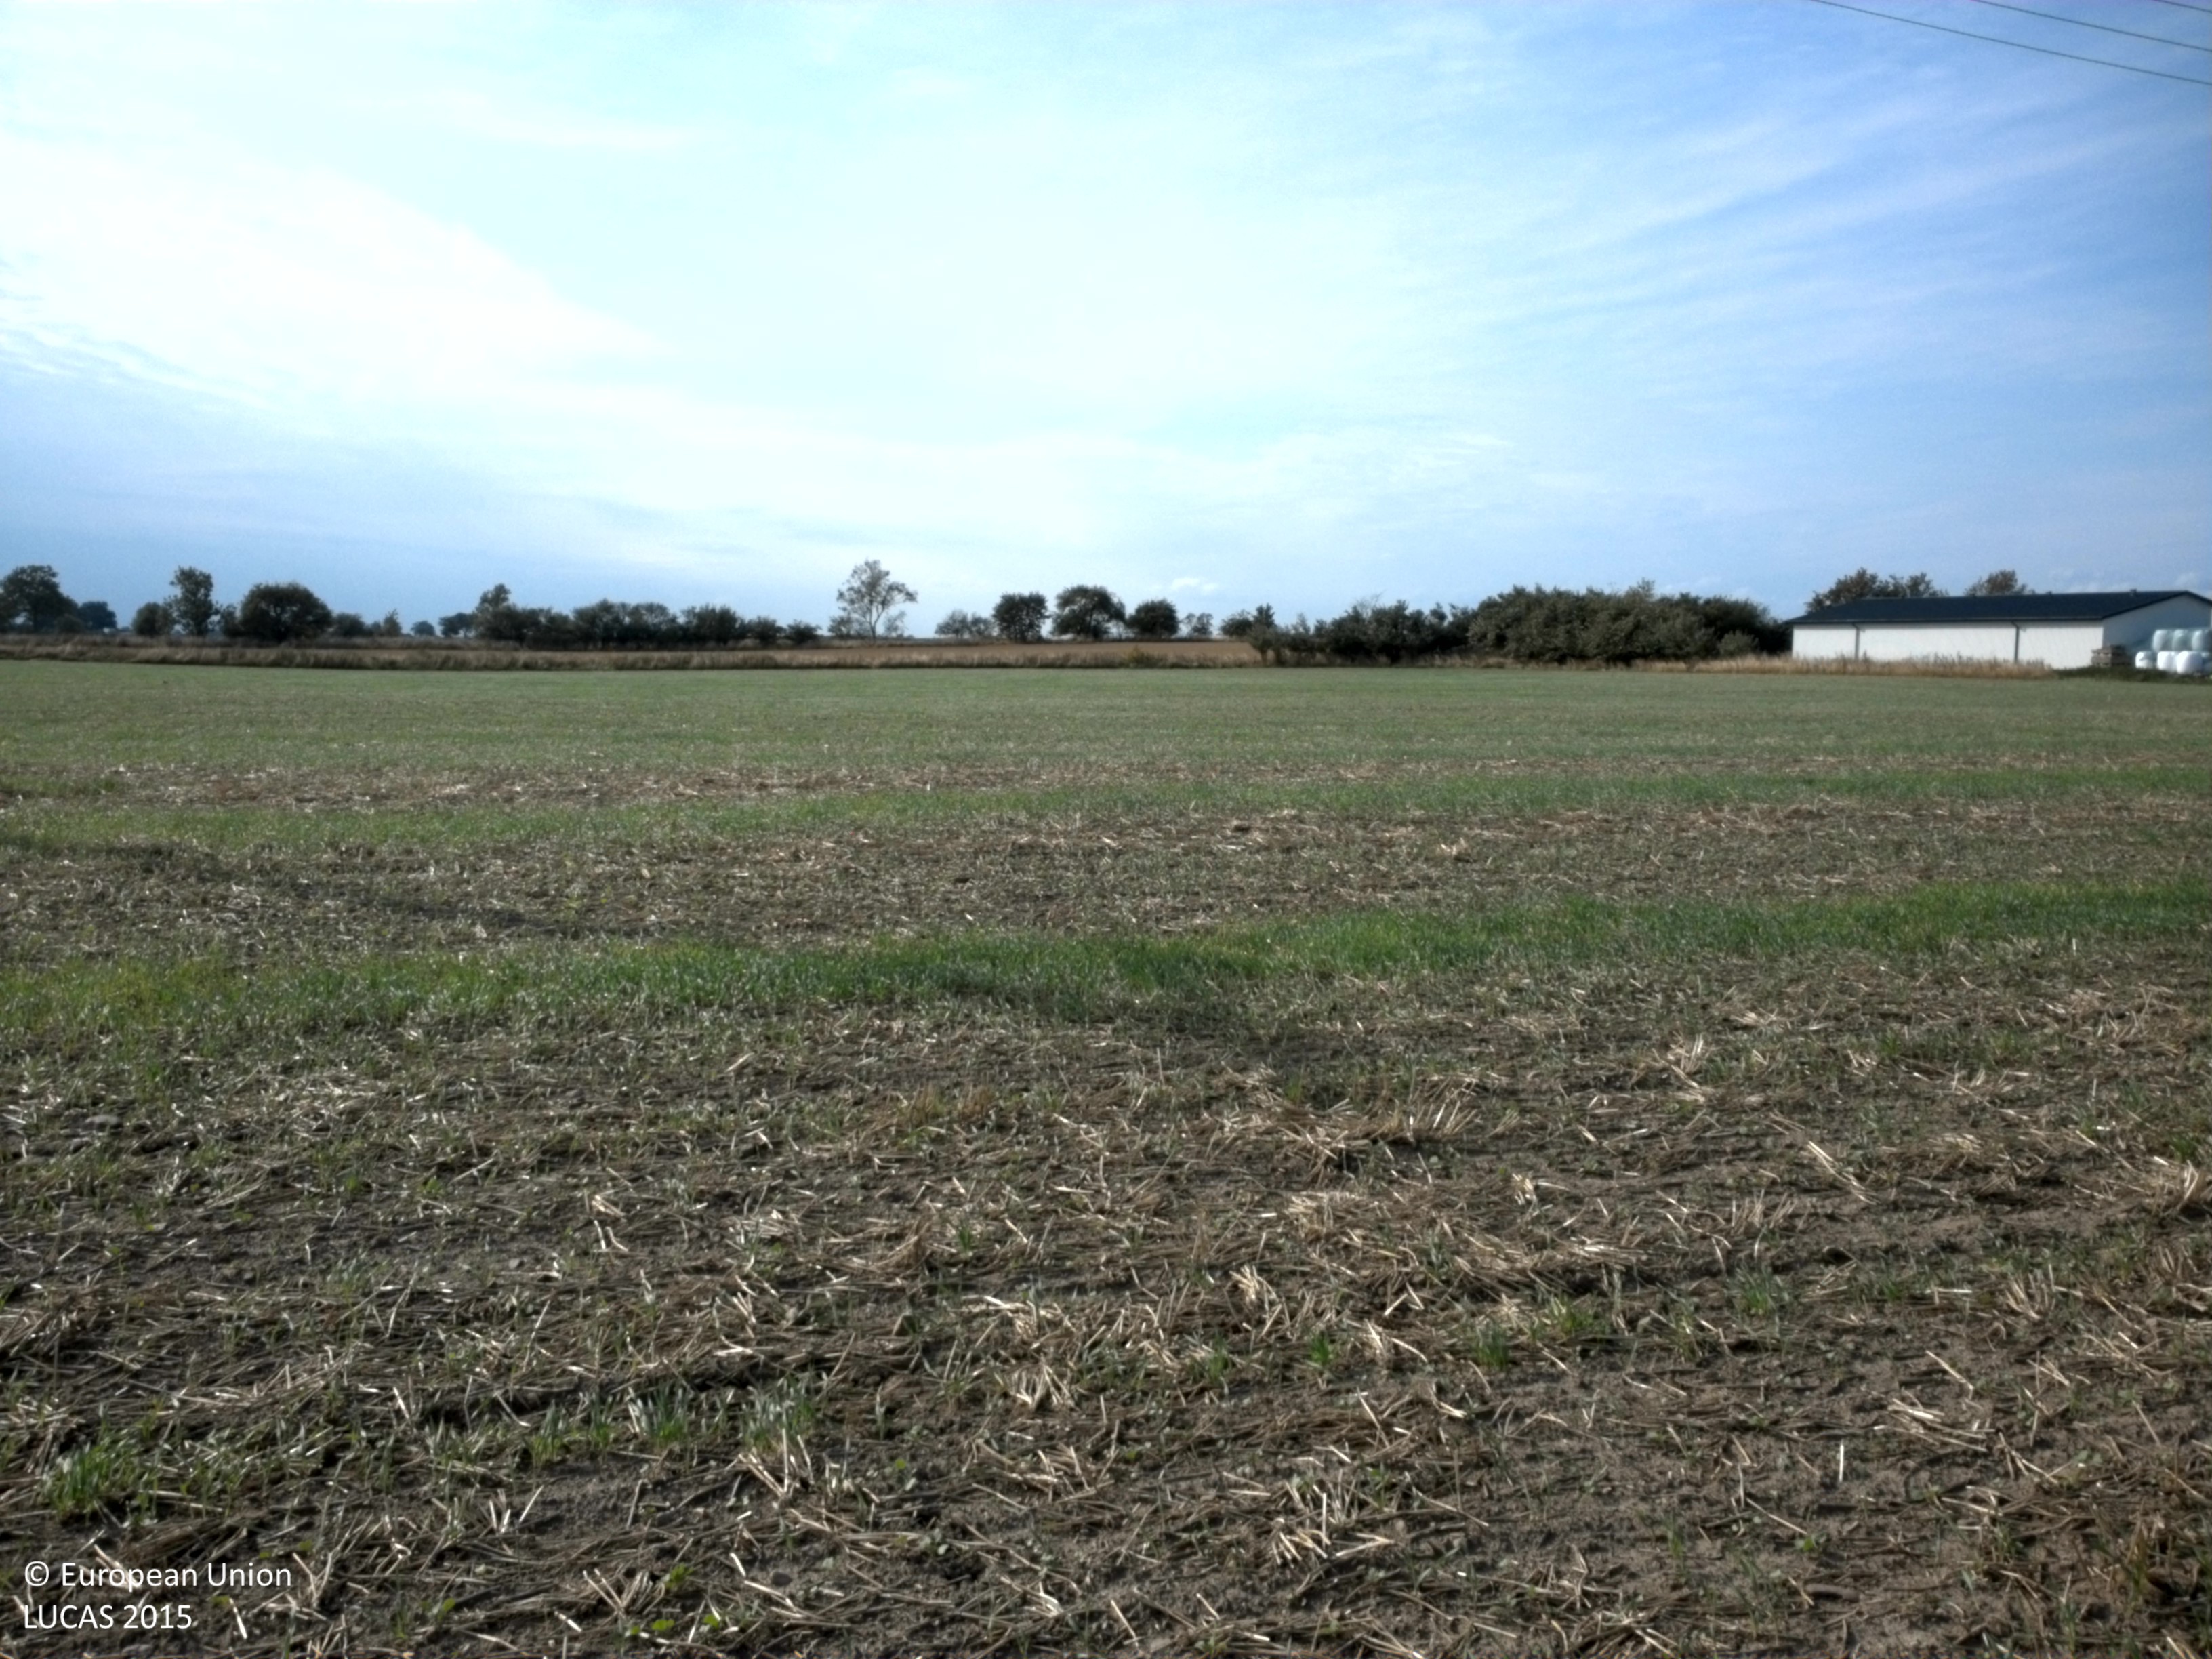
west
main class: Cropland
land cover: Other leguminous and mixtures for fodder
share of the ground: 10 - 25 %
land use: Agriculture (excluding fallow land and kitchen gardens)
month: September
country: SE
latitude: 55.5303
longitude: 14.0384
